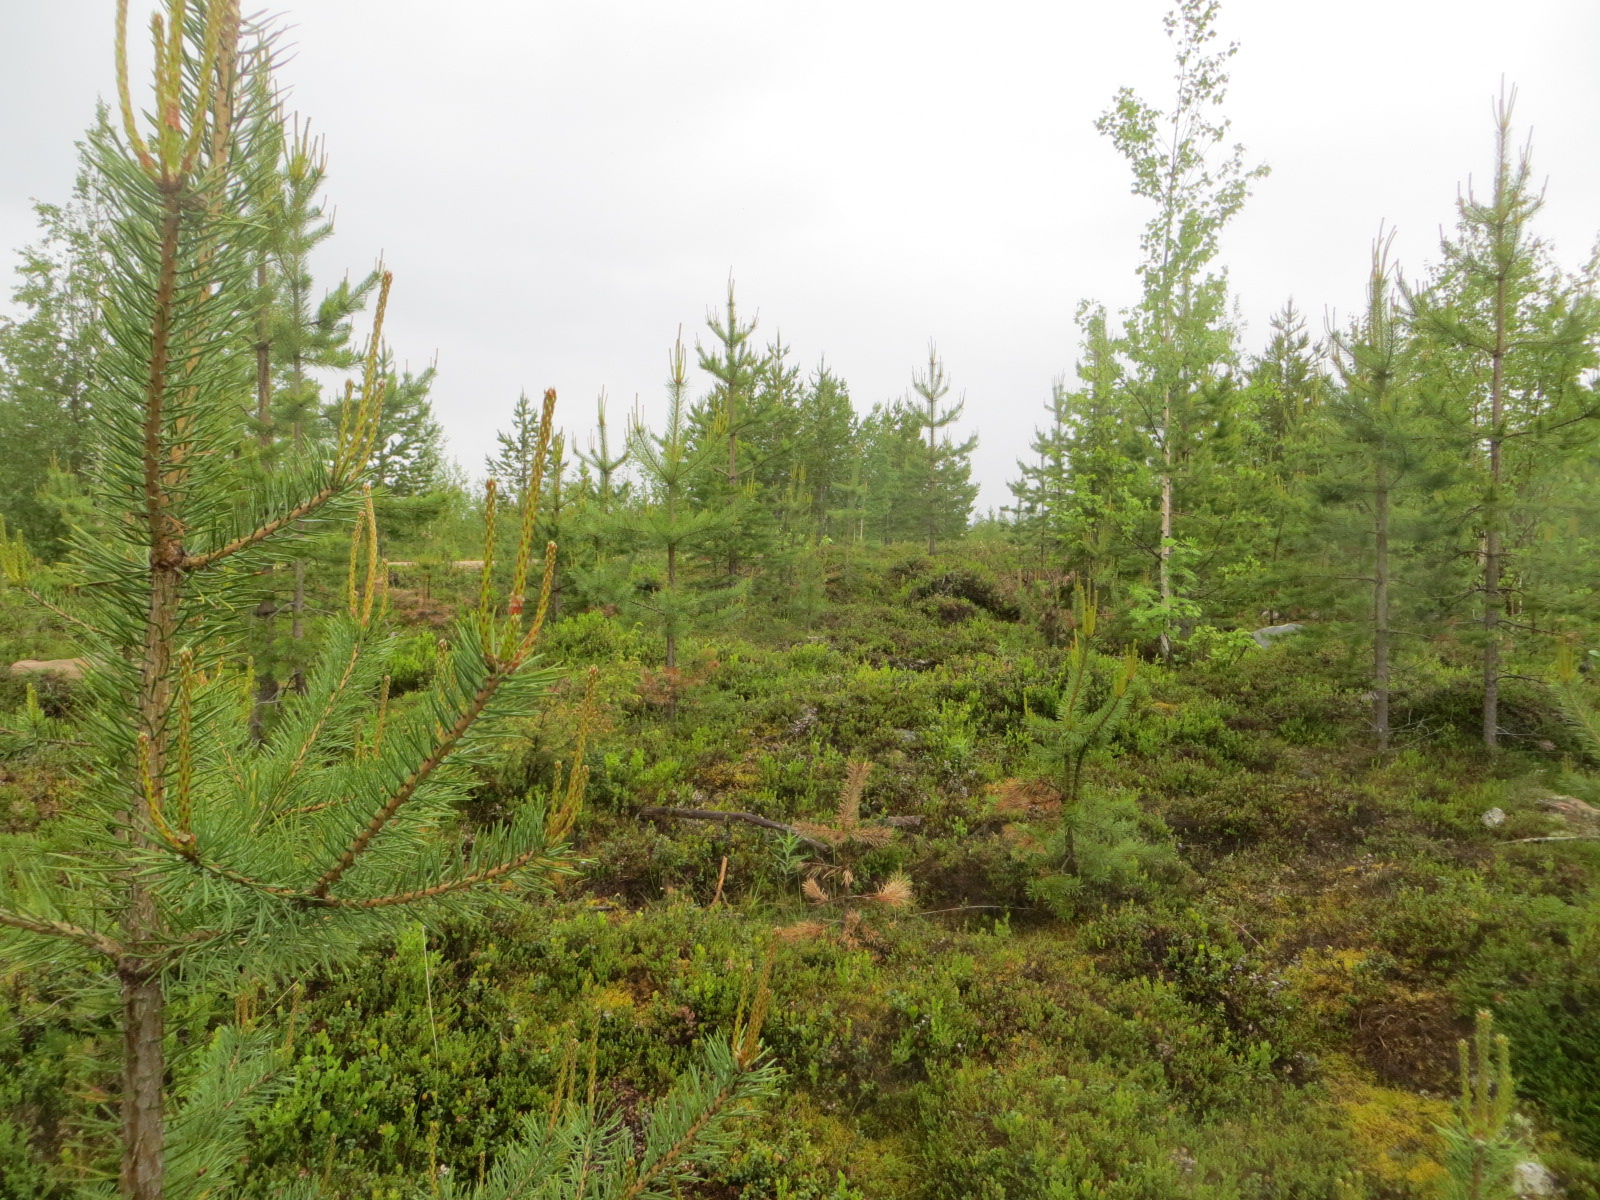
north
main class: Woodland
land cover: Pine dominated mixed woodland
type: boreal forest
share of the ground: 50 - 75 %
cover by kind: coniferous forest trees 45 %, broadleaved forest trees 25 %, shrubs 20 %, lichens and mosses 10 %
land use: Forestry
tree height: < 5 m
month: June
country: FI
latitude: 66.0249
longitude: 26.9332
